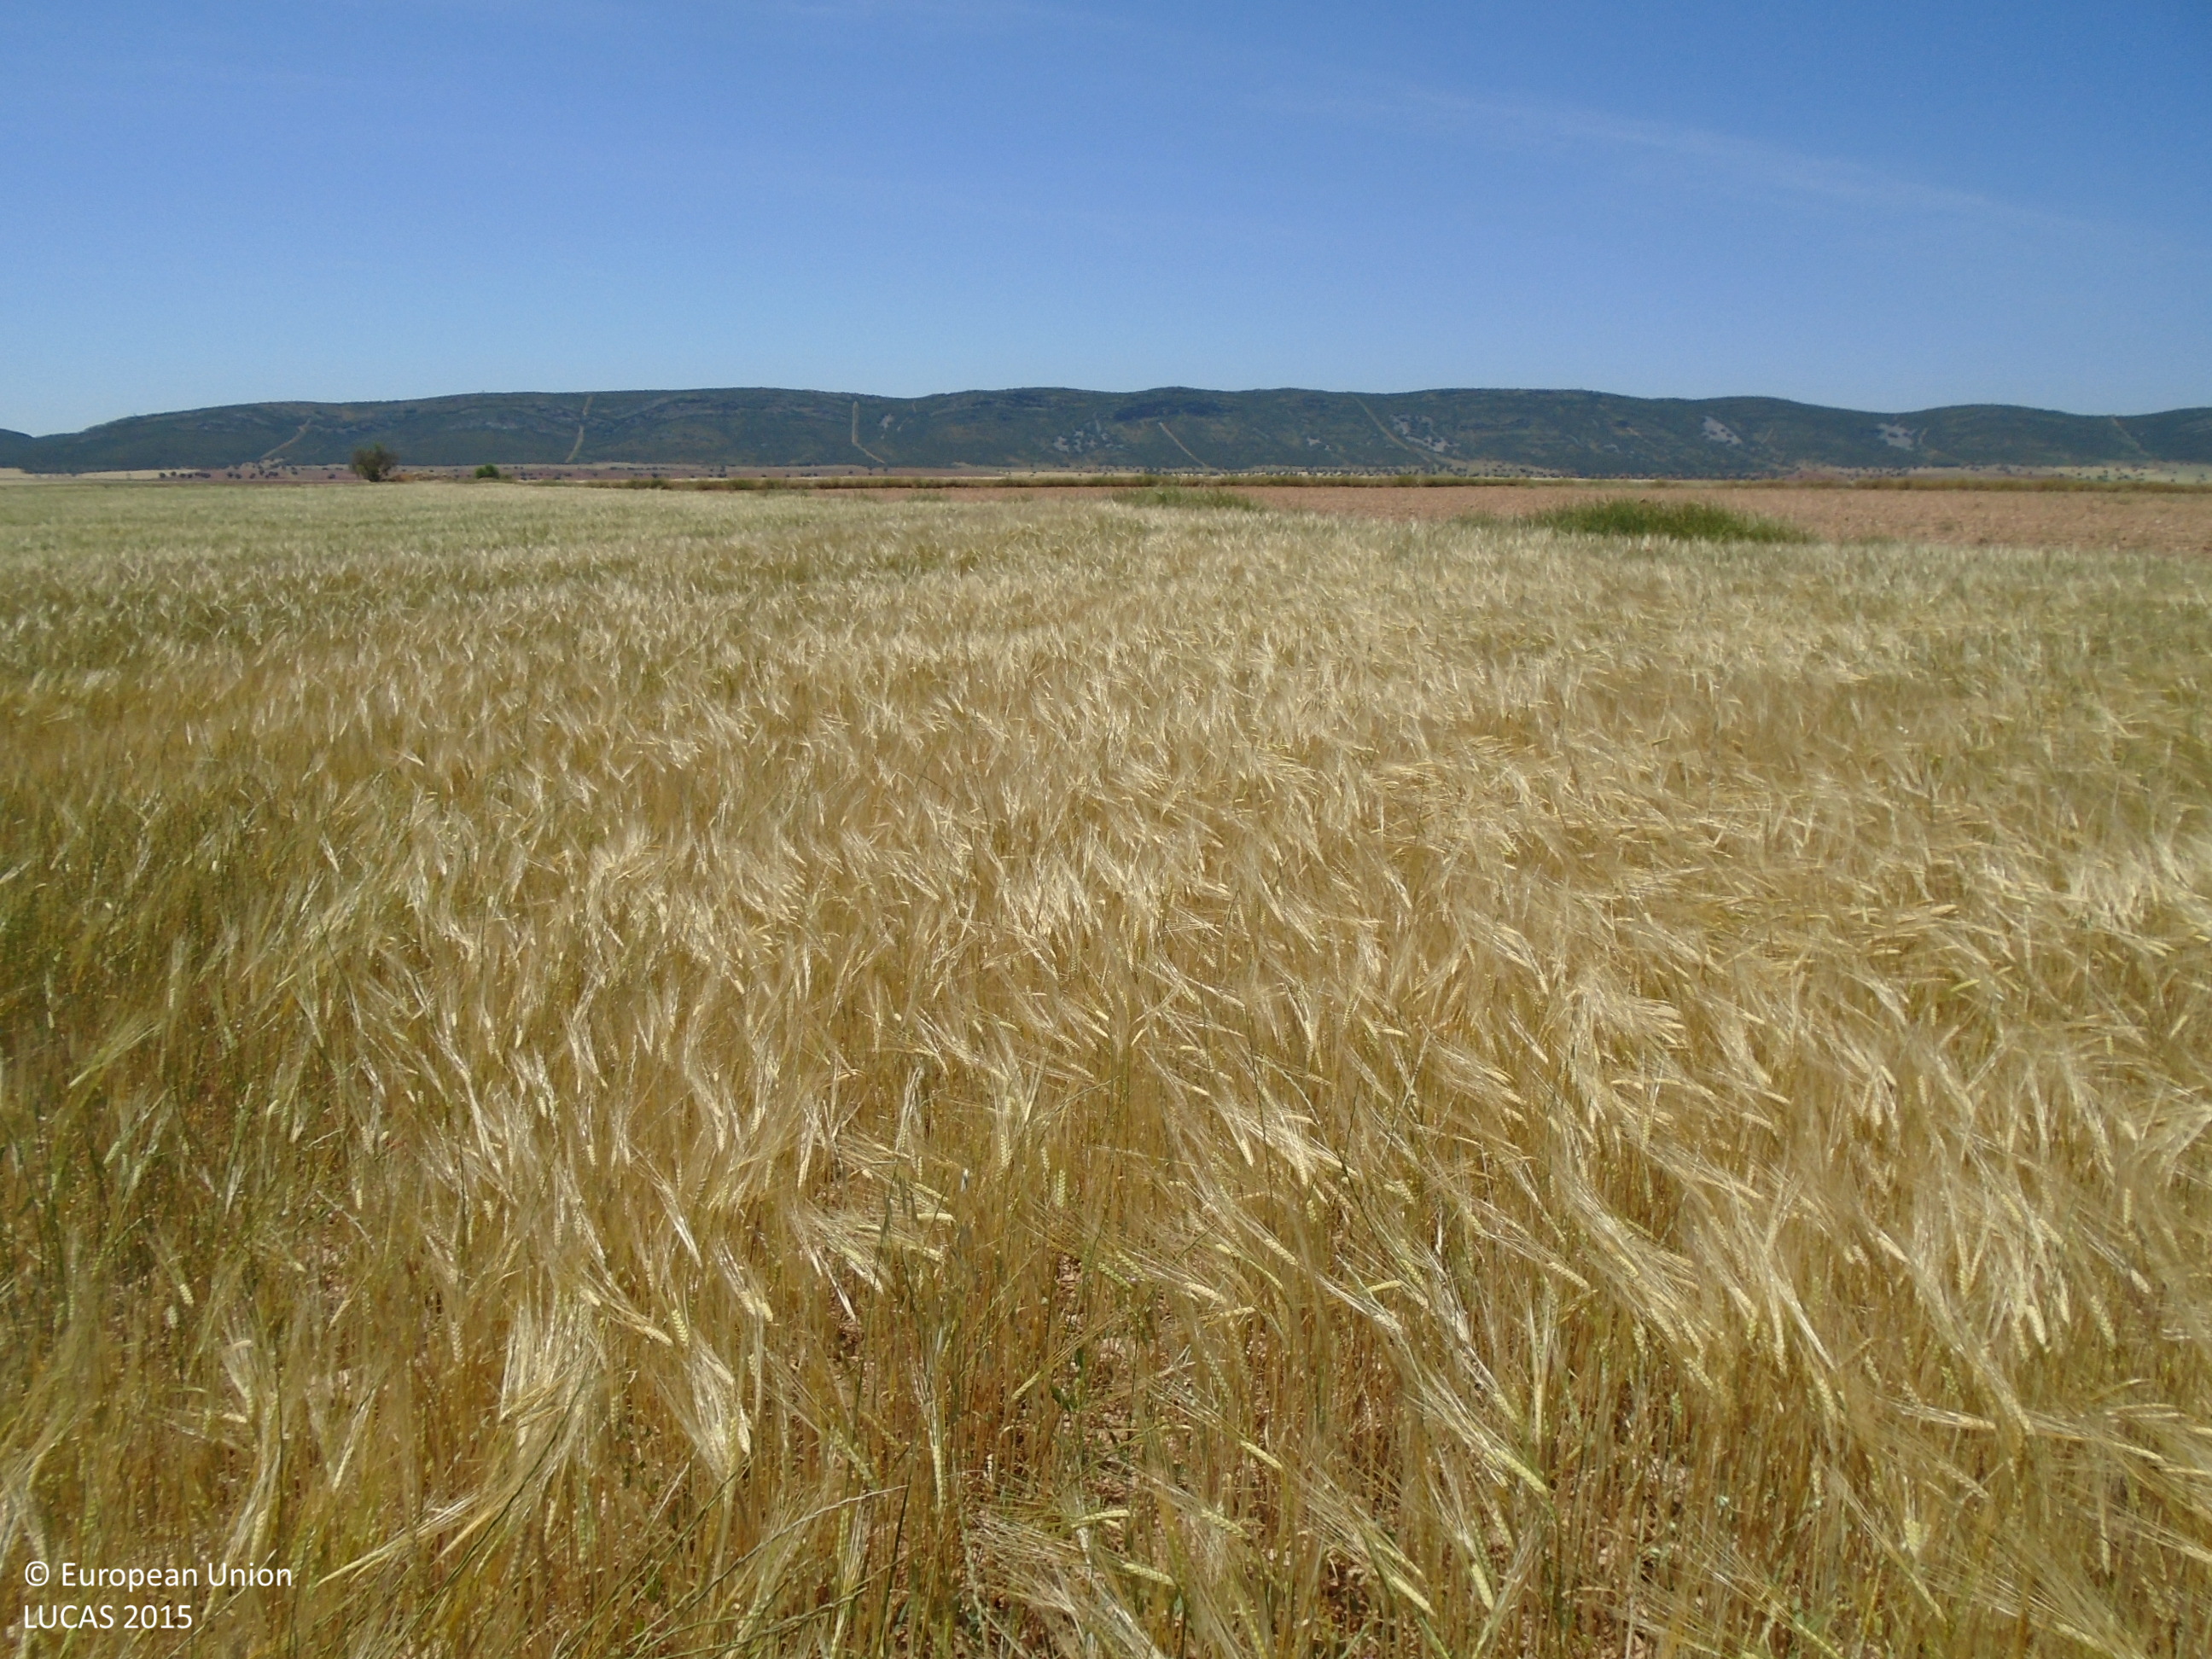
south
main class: Cropland
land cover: Barley
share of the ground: > 75 %
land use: Agriculture (excluding fallow land and kitchen gardens)
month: May
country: ES
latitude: 39.4978
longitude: -3.7356
